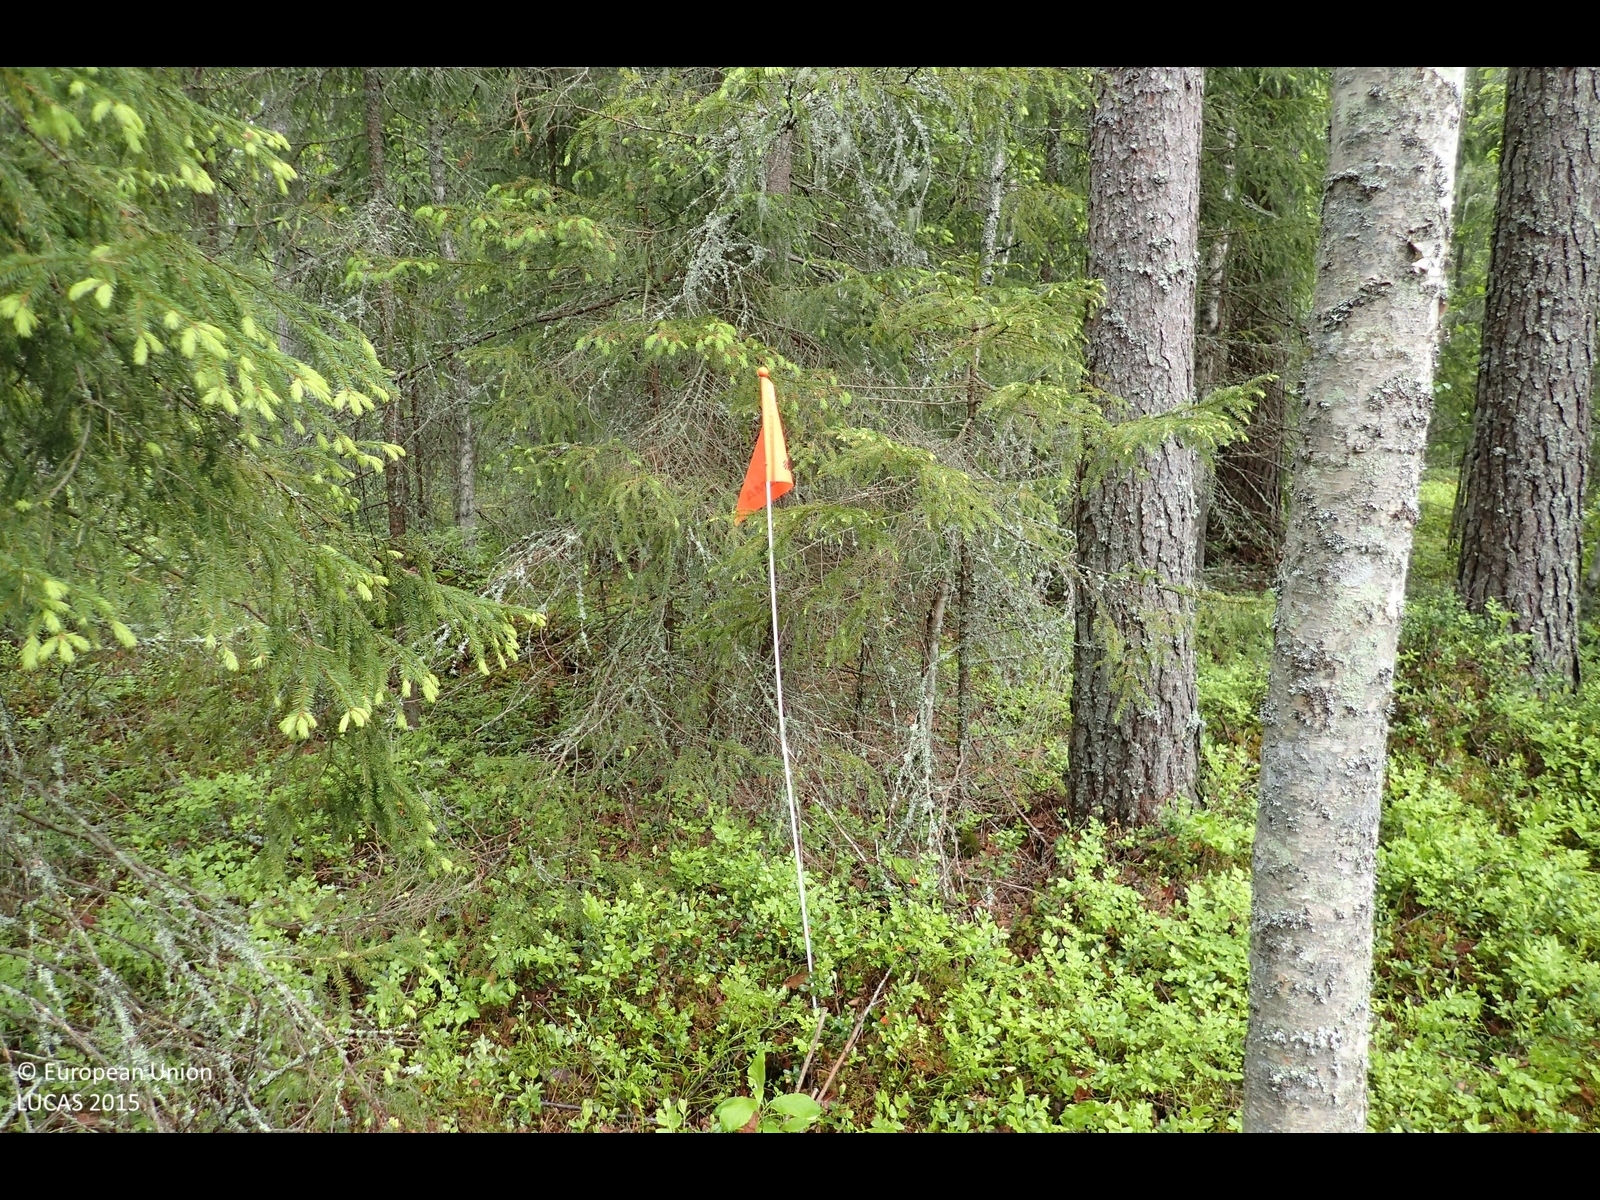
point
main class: Woodland
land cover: Pine dominated coniferous woodland
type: boreal forest
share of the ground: > 75 %
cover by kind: coniferous forest trees 75 %, shrubs 20 %, broadleaved forest trees 5 %
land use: Forestry
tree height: > 5 m
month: June
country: FI
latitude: 62.3515
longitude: 23.0654
